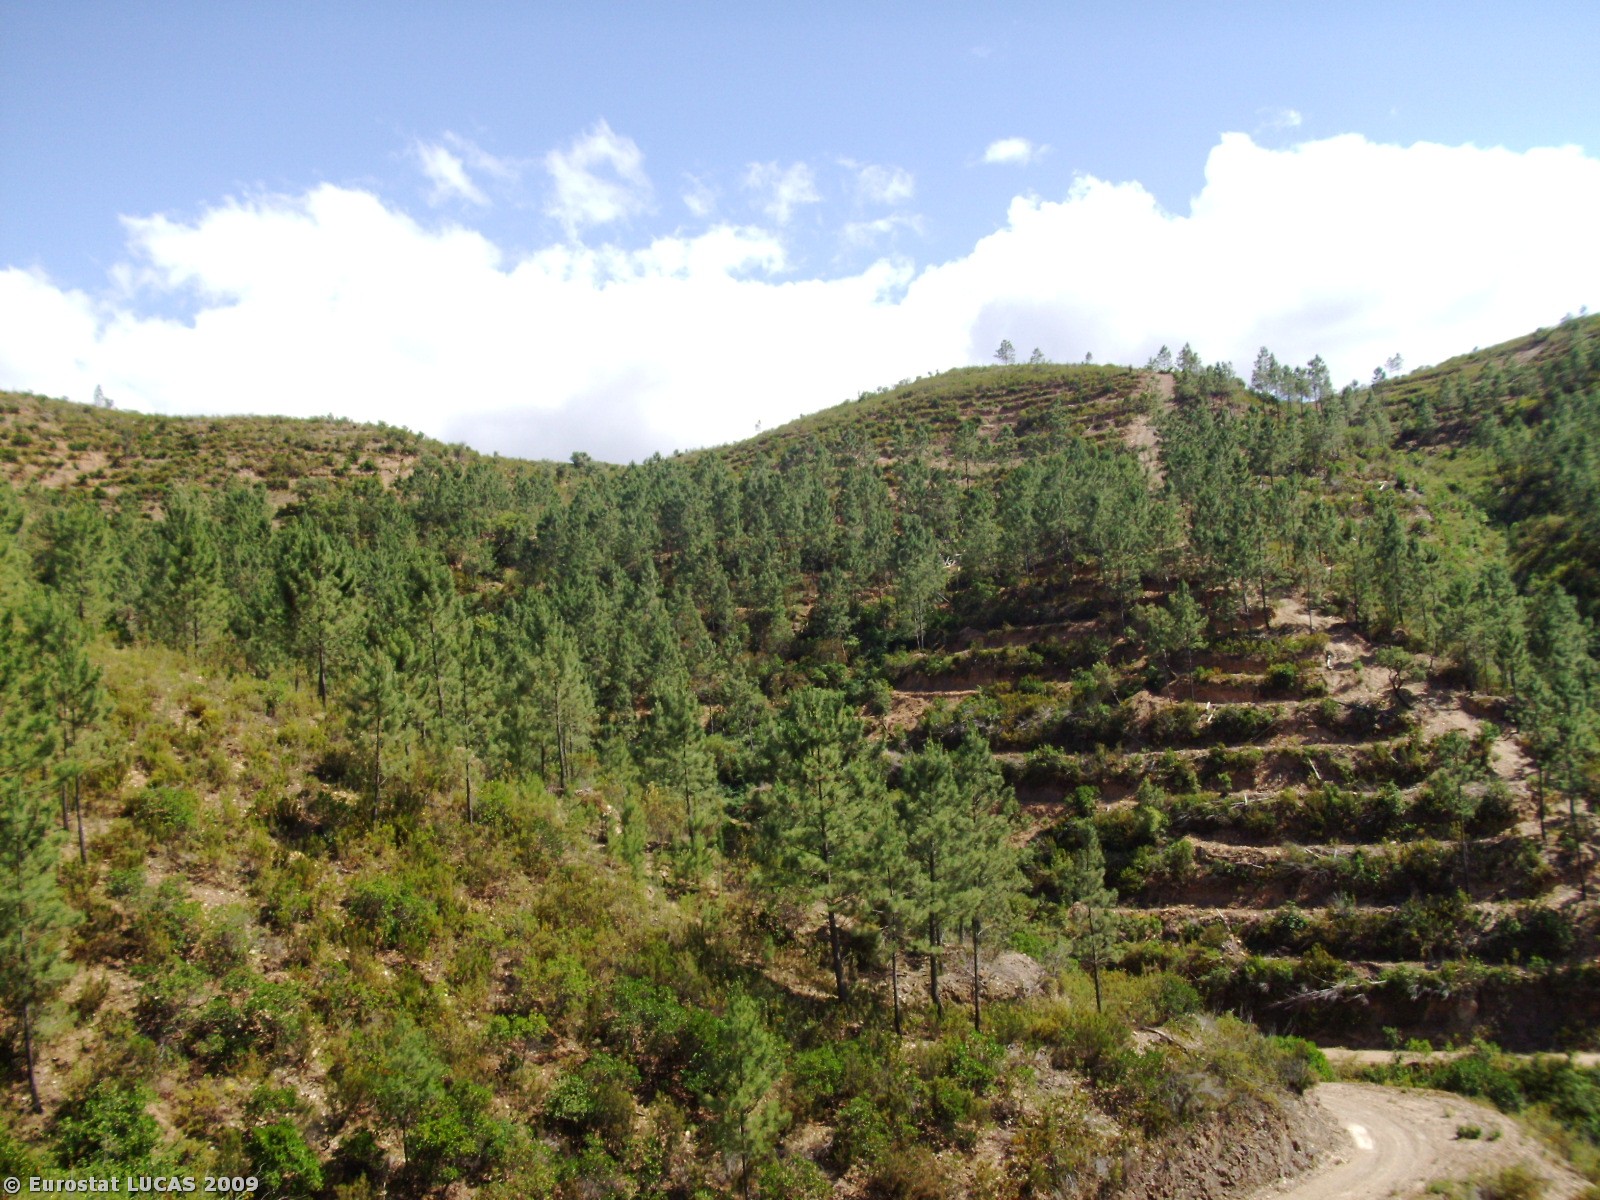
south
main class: Woodland
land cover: Coniferous woodland
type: coniferous forest of the mediterranean region
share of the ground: 25 - 50 %
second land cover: Shrubland with sparse tree cover
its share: 25 - 50 %
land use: Nature reserves
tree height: > 5 m
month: June
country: PT
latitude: 37.3014
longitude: -8.4268
